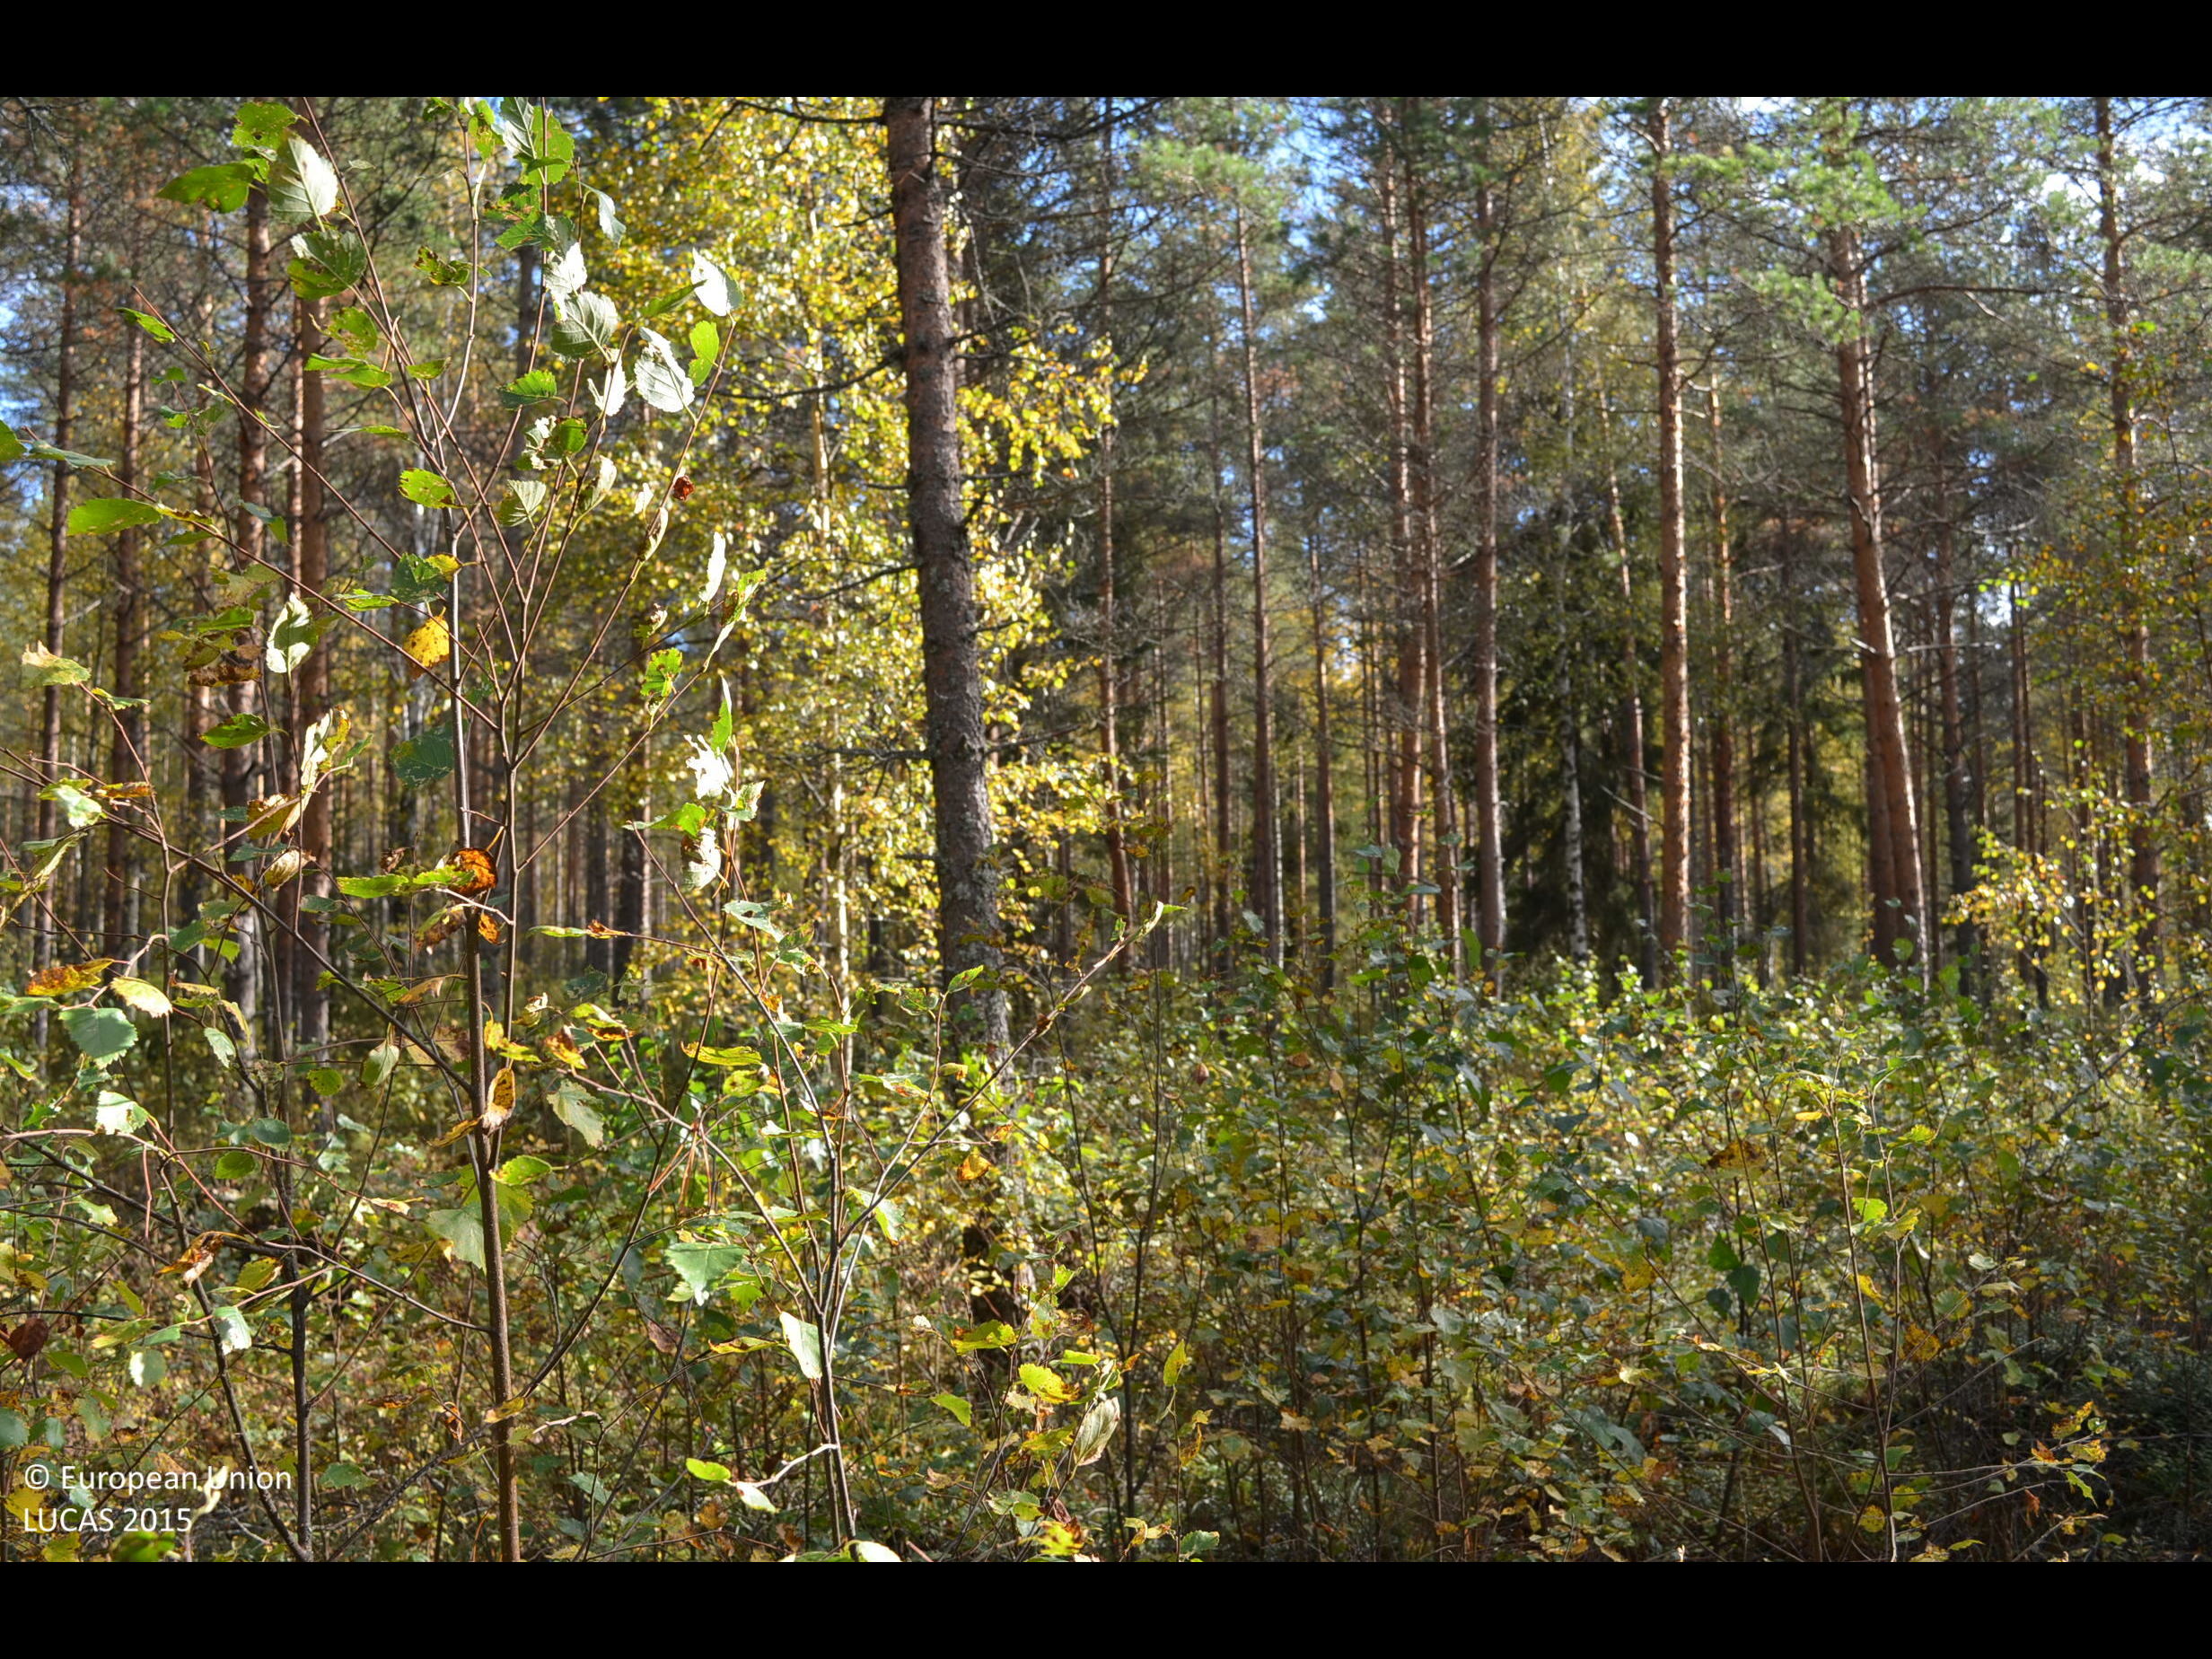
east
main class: Woodland
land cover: Pine dominated coniferous woodland
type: boreal forest
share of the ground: > 75 %
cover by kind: coniferous forest trees 60 %, shrubs 20 %, broadleaved forest trees 15 %, herbaceous plants 5 %
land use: Forestry
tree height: > 5 m
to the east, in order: Pine dominated coniferous woodland; Ditches and canals; Other mixed woodland; Ditches and canals; Pine dominated coniferous woodland; Ditches and canals; Pine dominated mixed woodland
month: September
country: FI
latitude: 62.9206
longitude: 23.8767
